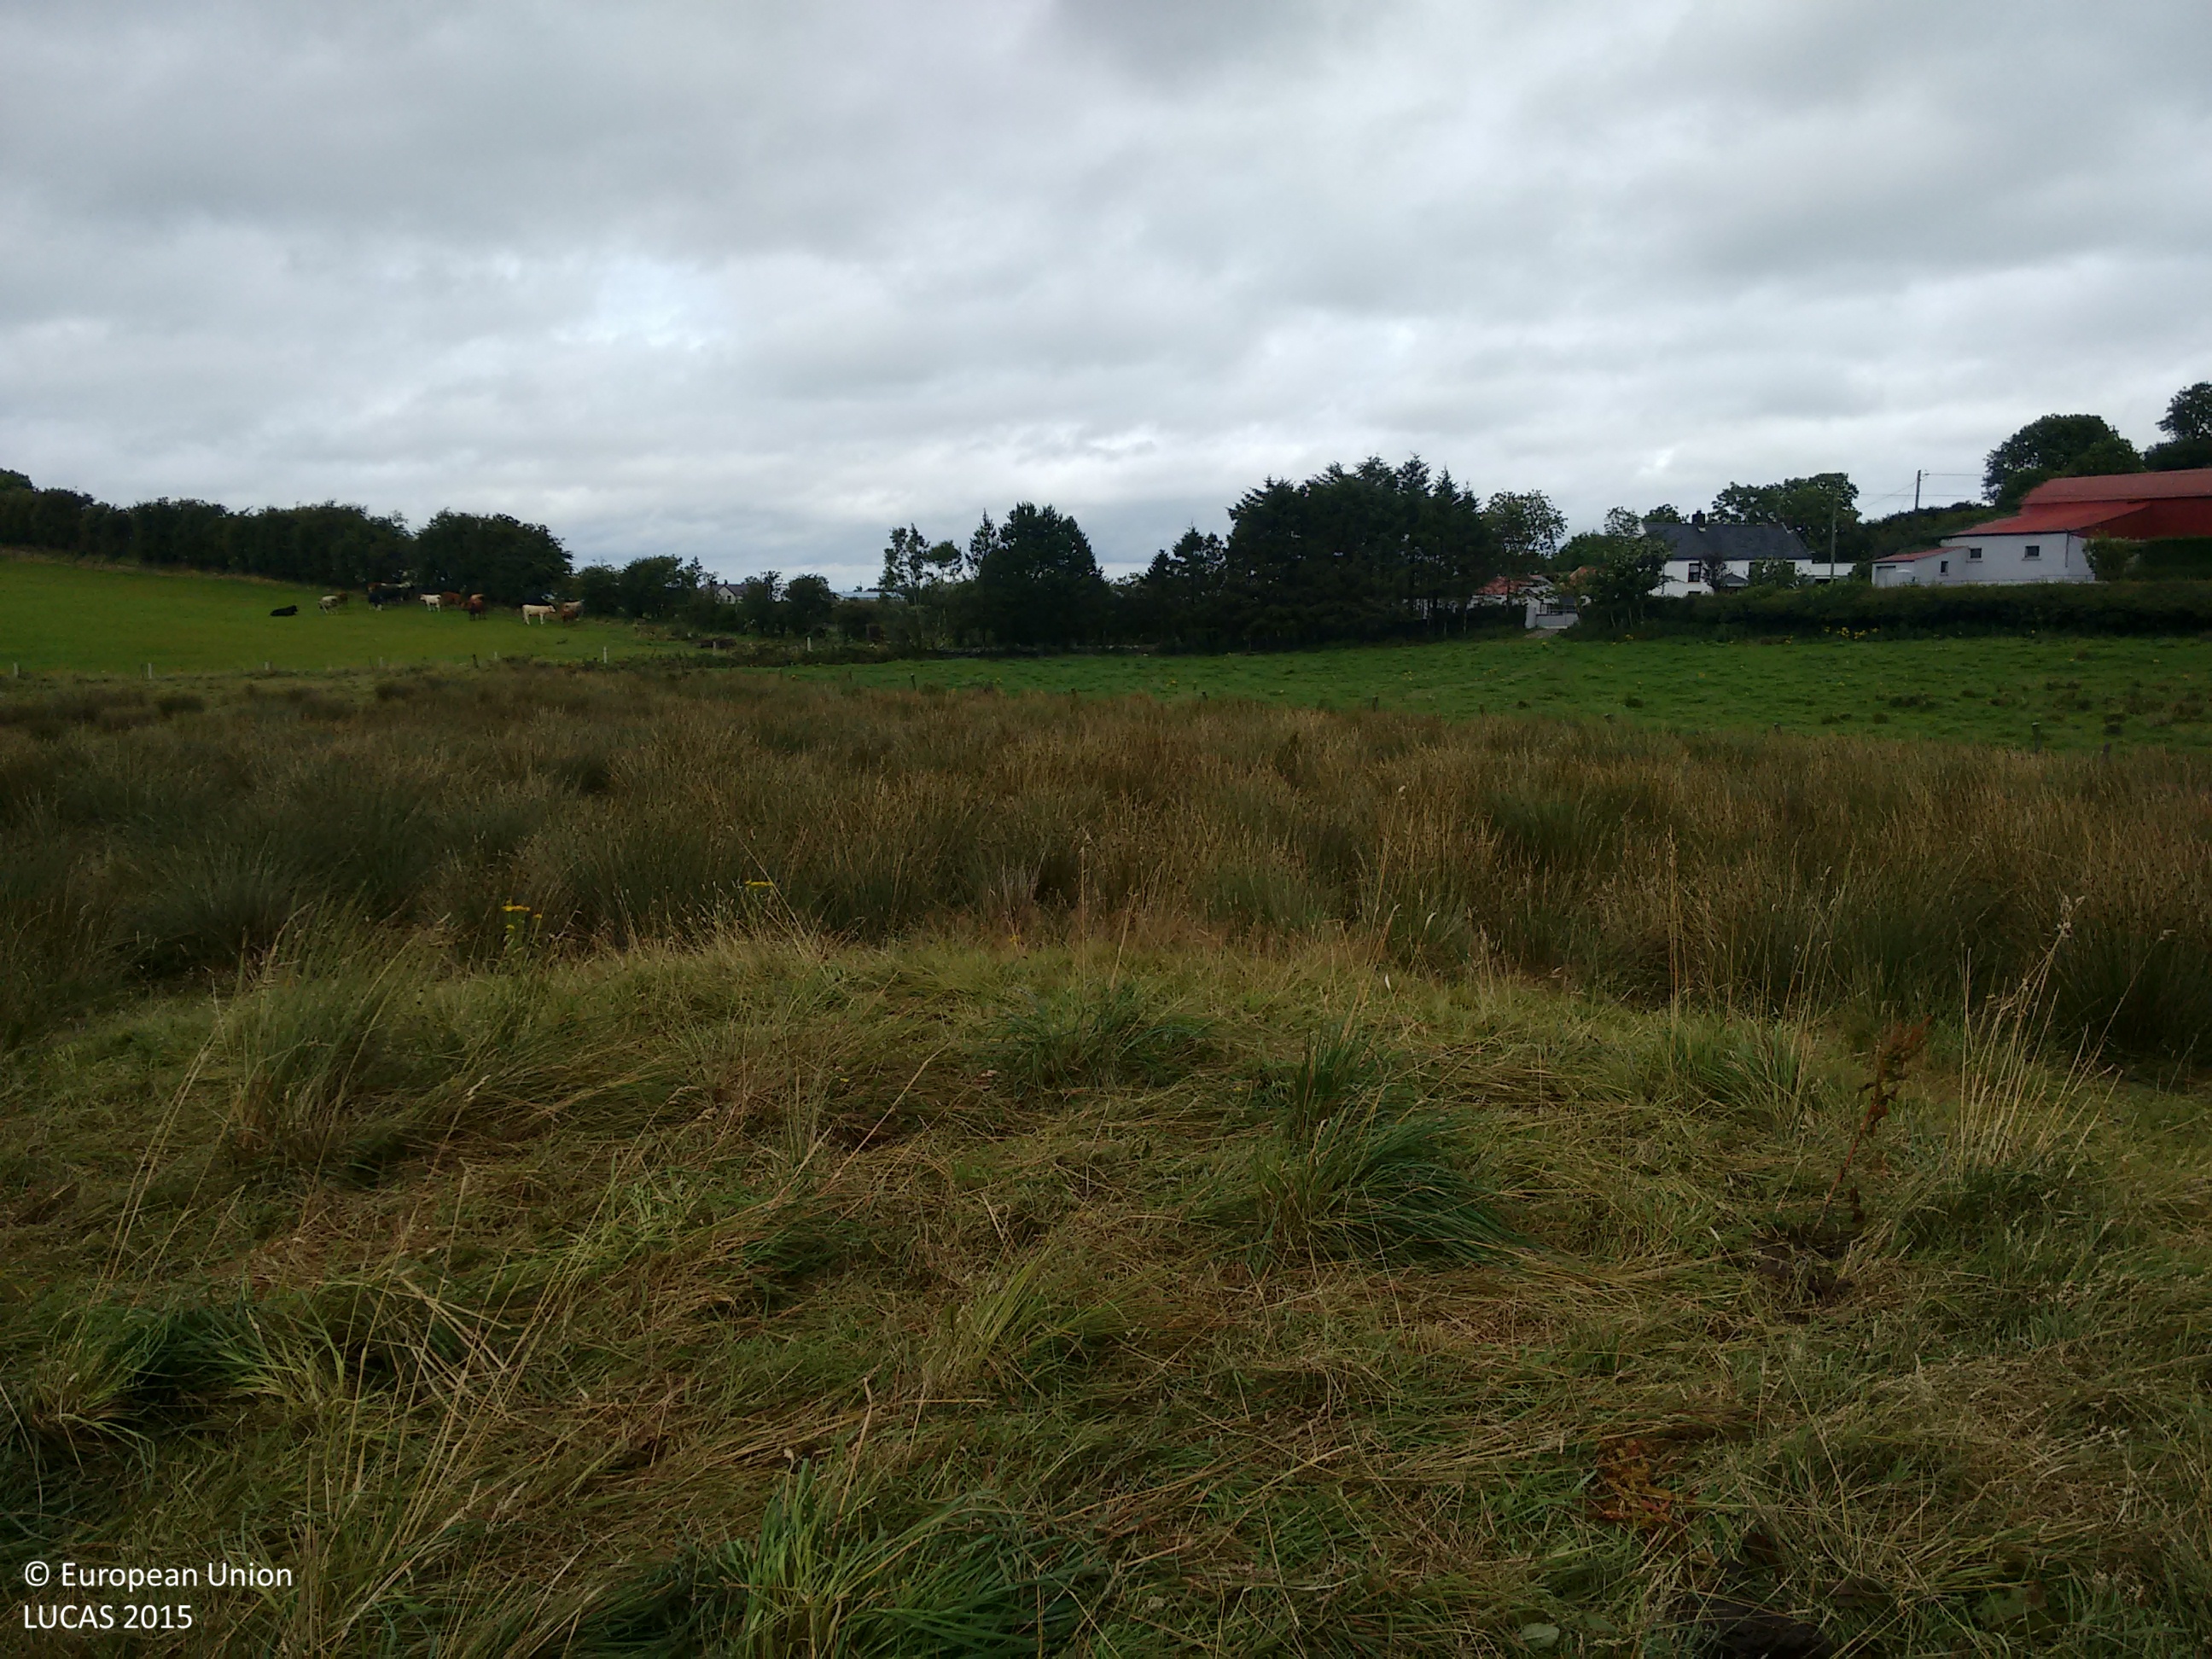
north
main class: Grassland
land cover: Grassland with sparse tree/shrub cover
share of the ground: > 75 %
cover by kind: herbaceous plants 95 %, broadleaved forest trees 5 %
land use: Agriculture (excluding fallow land and kitchen gardens)
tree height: < 5 m
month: August
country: IE
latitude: 54.0901
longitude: -6.8149
